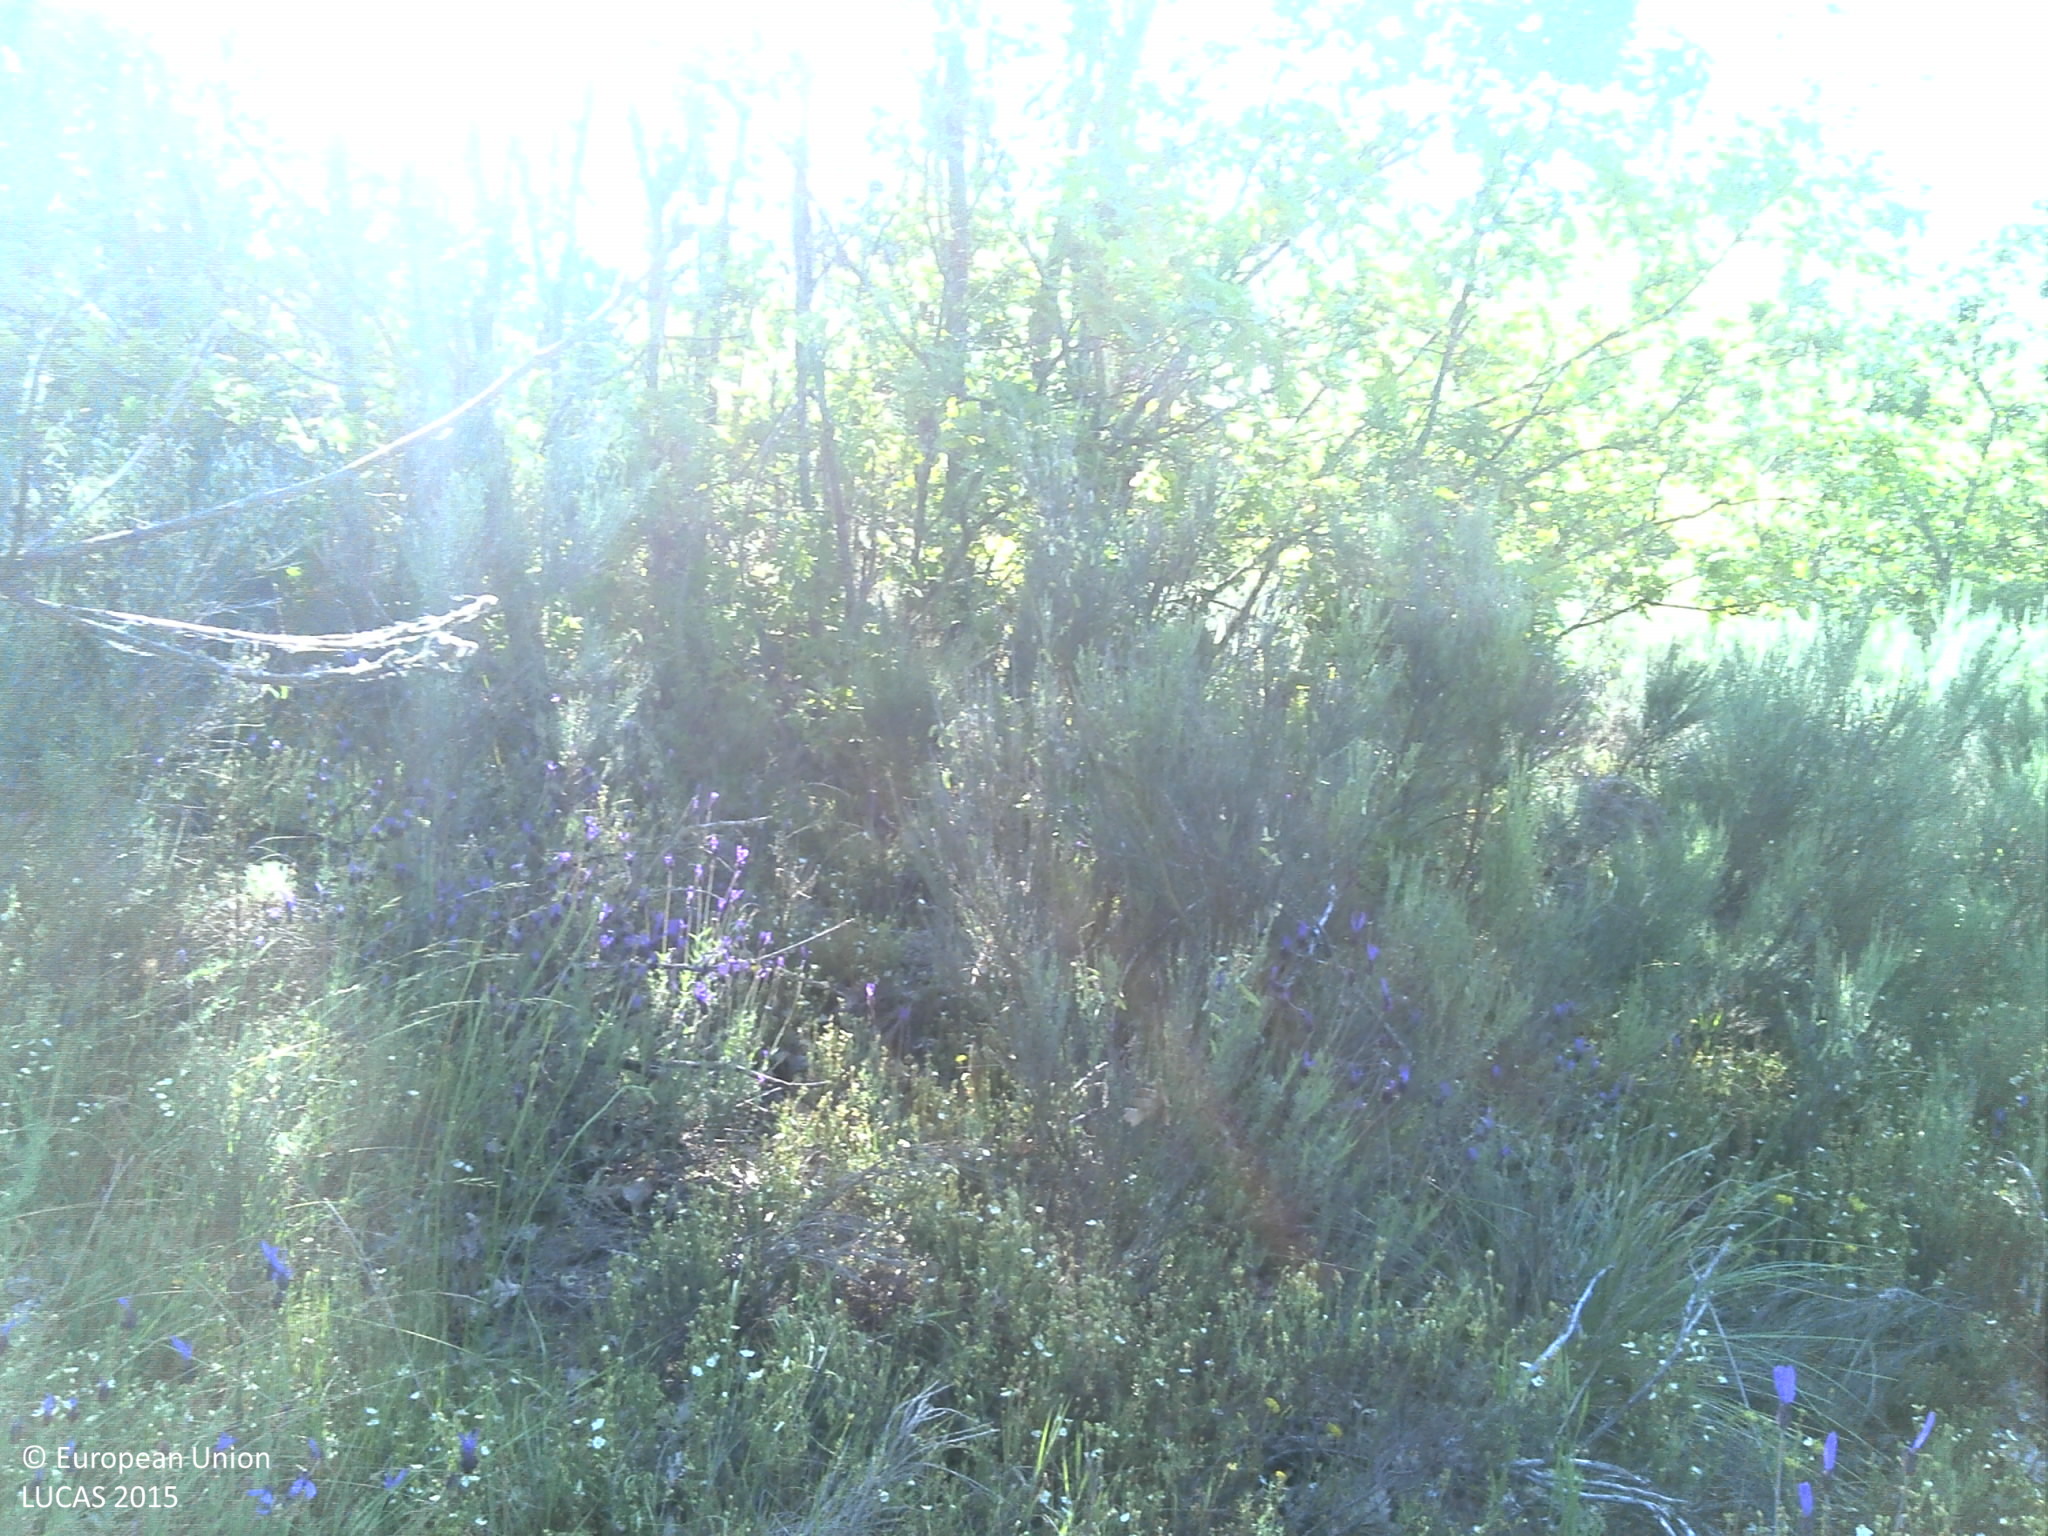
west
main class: Woodland
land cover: Other mixed woodland
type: acidophilous oak and oak-birch forest
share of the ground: 10 - 25 %
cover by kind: shrubs 35 %, herbaceous plants 20 %, unconsolidated bare surface 20 %, broadleaved forest trees 15 %, coniferous forest trees 10 %
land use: Forestry
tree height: > 5 m
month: May
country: PT
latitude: 41.6290
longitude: -6.3415
